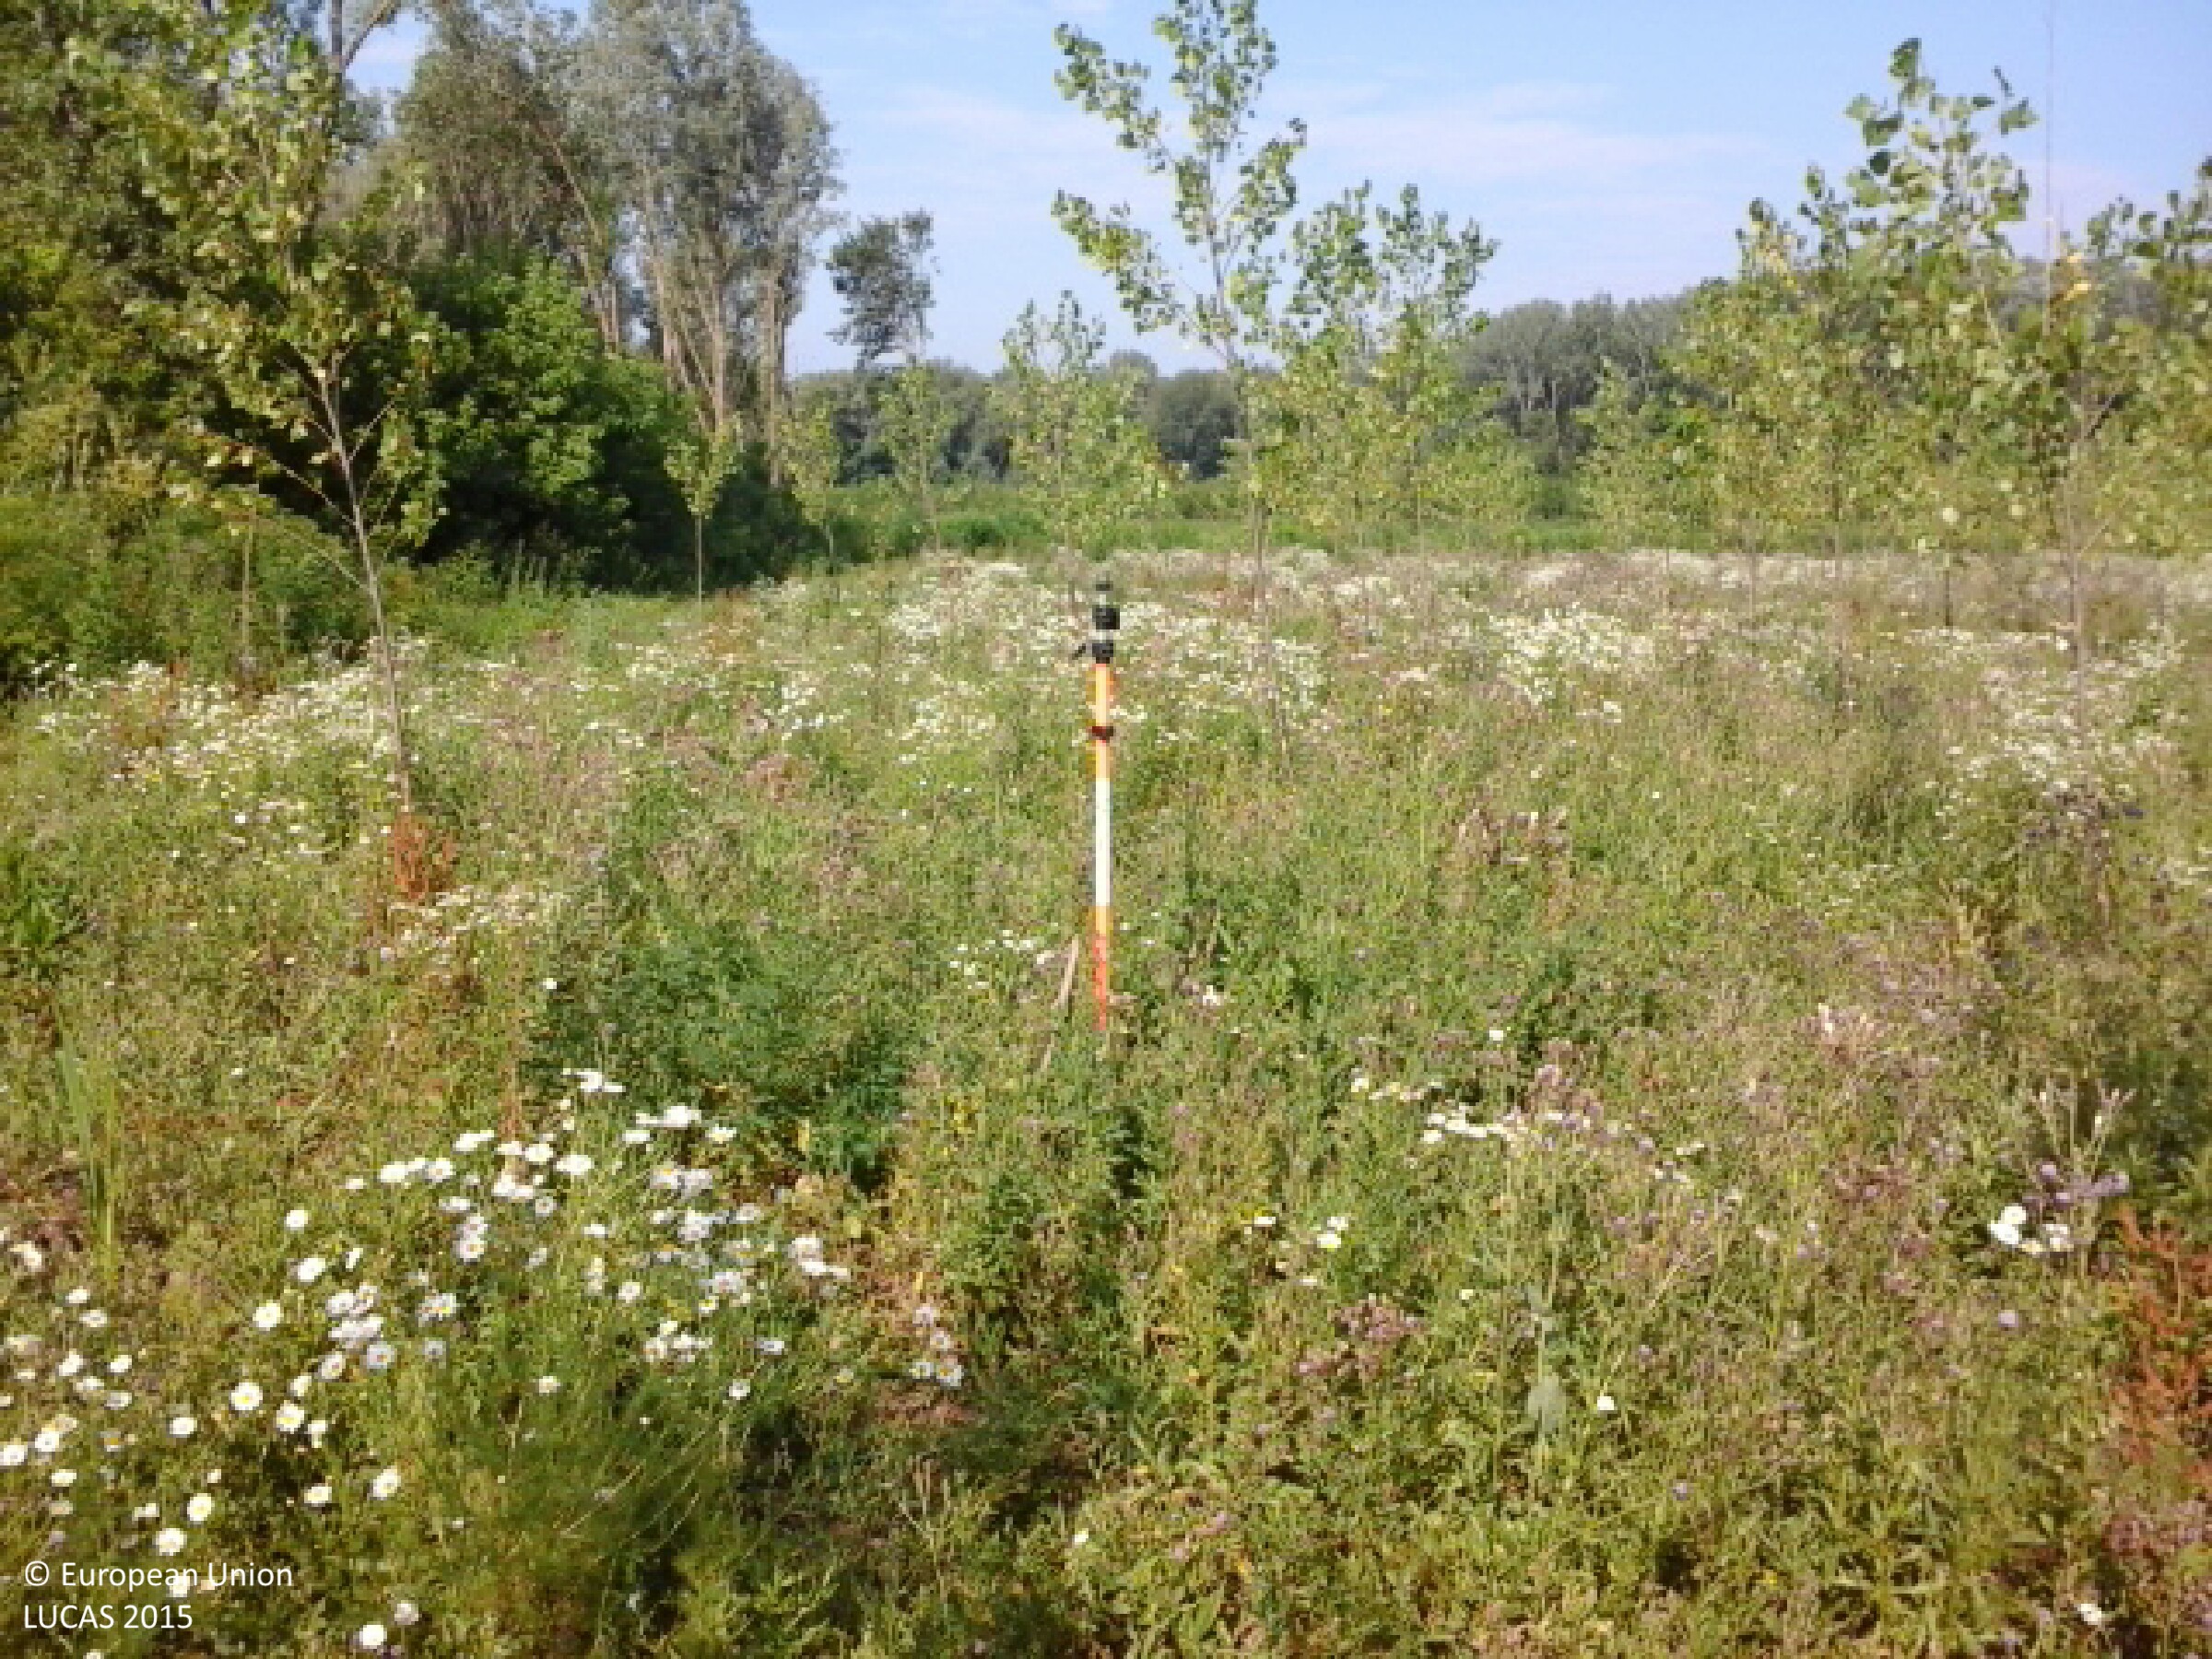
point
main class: Woodland
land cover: Broadleaved woodland
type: non-riverine alder, birch or aspen forest
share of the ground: 25 - 50 %
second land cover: Grassland without tree/shrub cover
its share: > 75 %
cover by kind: herbaceous plants 55 %, broadleaved forest trees 40 %, shrubs 5 %
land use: Forestry
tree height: < 5 m
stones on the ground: < 10 %
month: June
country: HU
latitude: 48.1938
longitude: 21.7398
